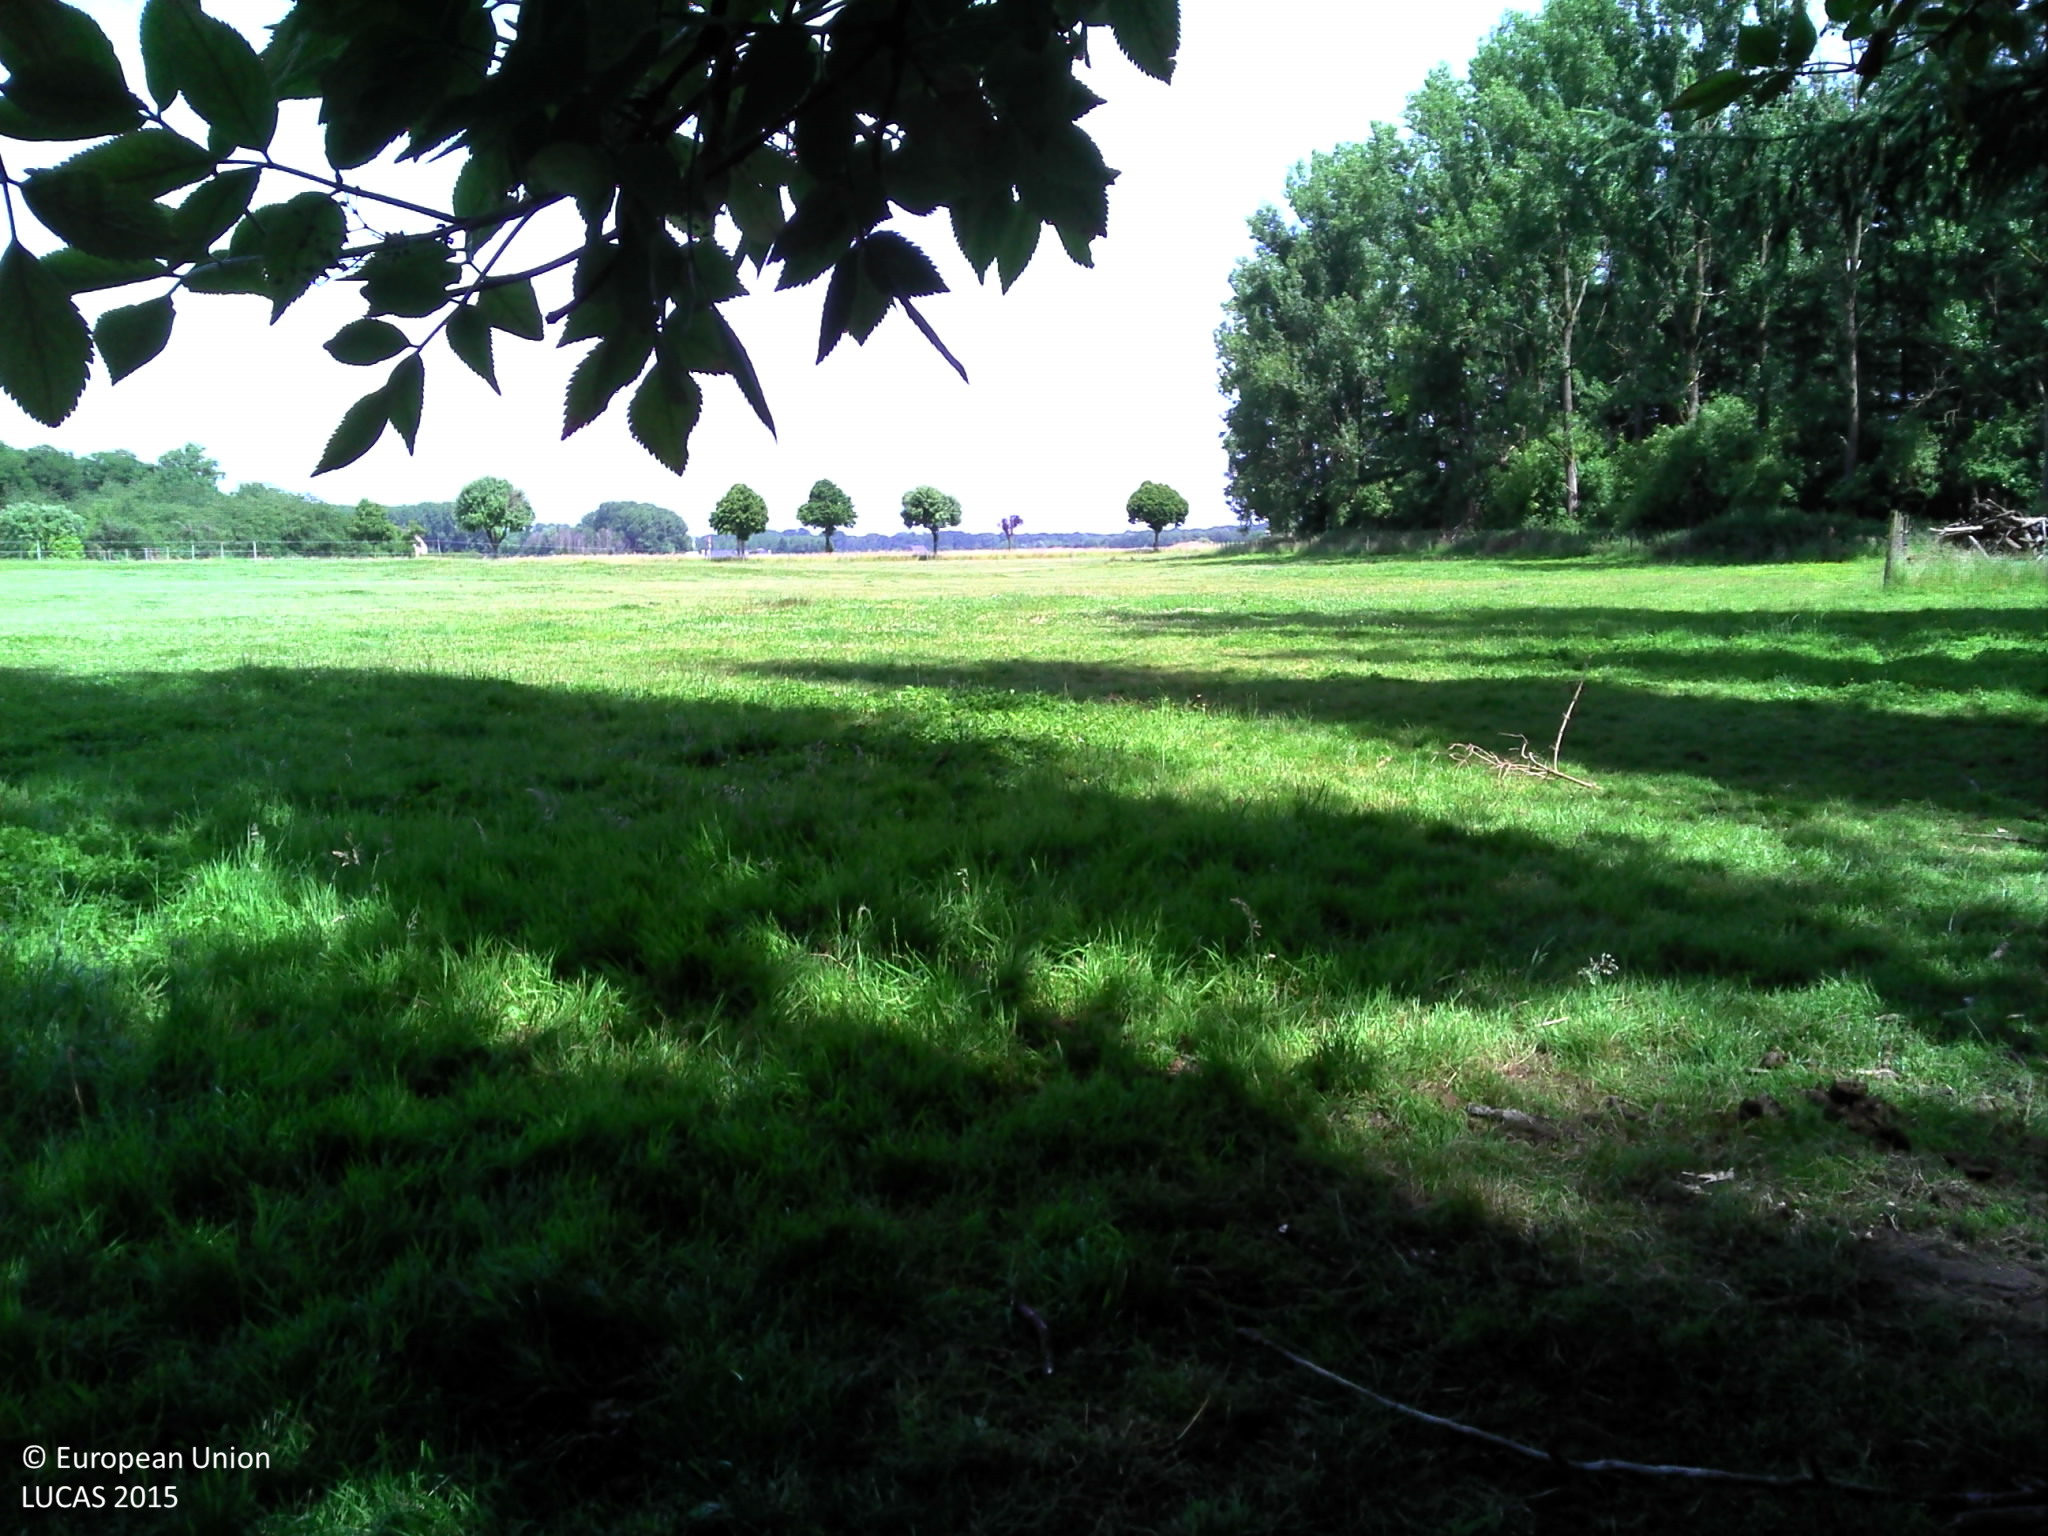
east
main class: Woodland
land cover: Spruce dominated mixed woodland
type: acidophilous oak and oak-birch forest
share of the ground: > 75 %
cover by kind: coniferous forest trees 50 %, herbaceous plants 25 %, broadleaved forest trees 20 %, shrubs 5 %
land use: Forestry
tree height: > 5 m
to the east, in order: Spruce dominated mixed woodland; Fences; Grassland without tree/shrub cover; Fences; Grassland without tree/shrub cover; Fences; Grassland without tree/shrub cover
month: June
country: BE
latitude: 50.5144
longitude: 3.6892
